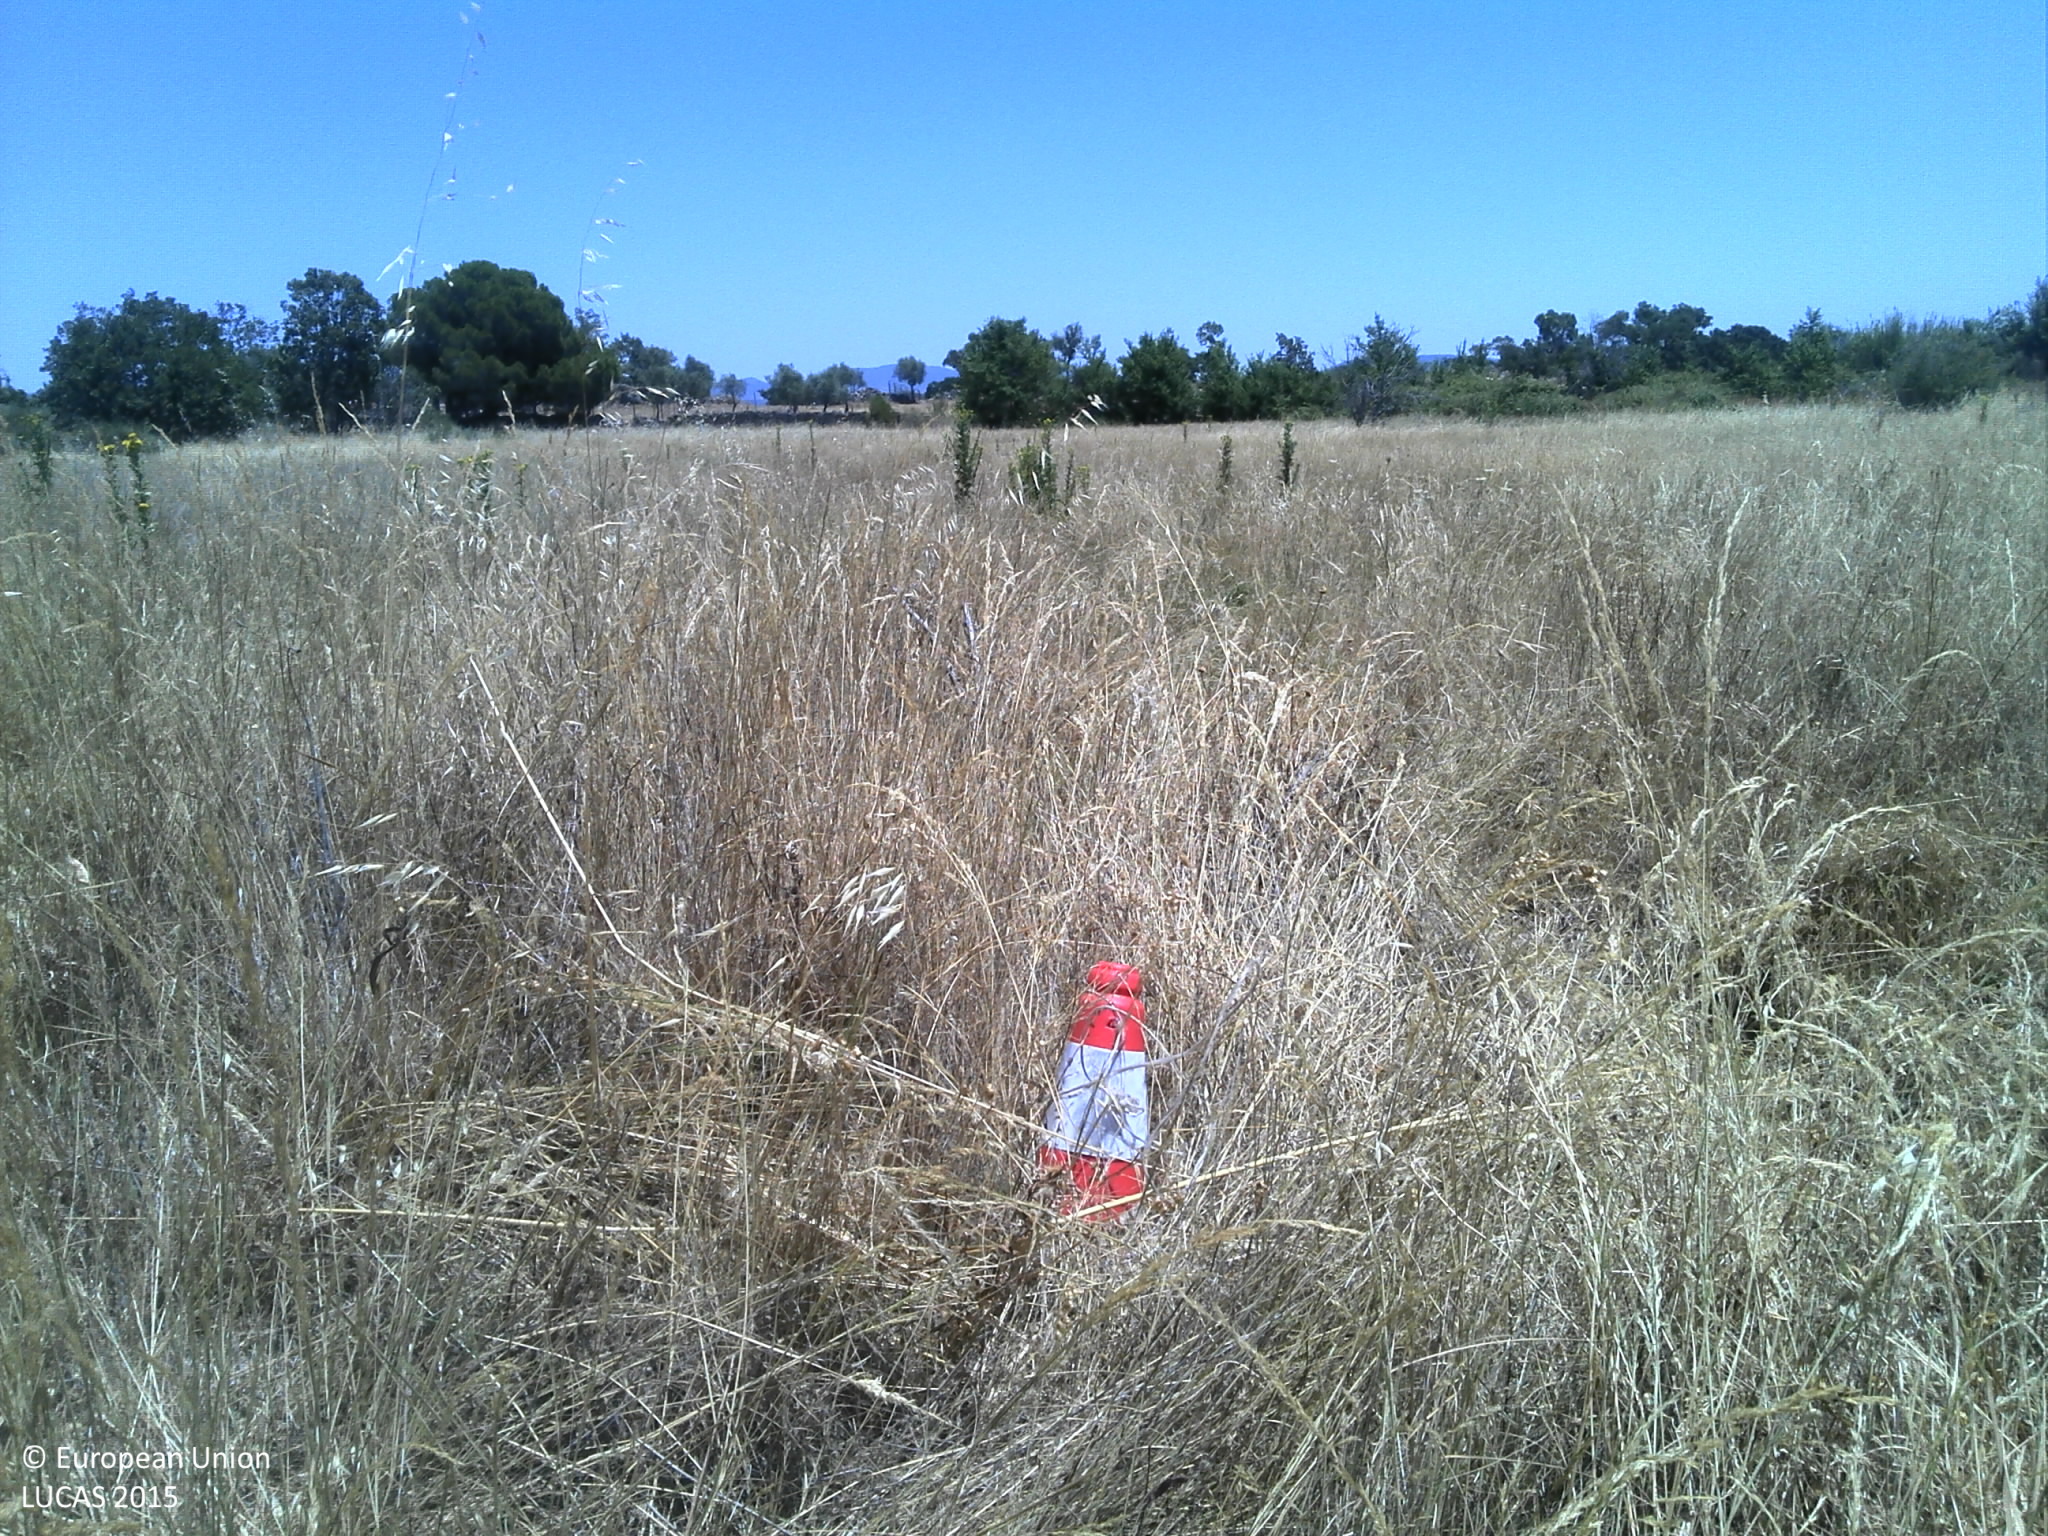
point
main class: Grassland
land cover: Grassland without tree/shrub cover
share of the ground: 50 - 75 %
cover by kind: herbaceous plants 75 %, unconsolidated bare surface 15 %
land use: Agriculture (excluding fallow land and kitchen gardens)
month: June
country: PT
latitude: 39.9455
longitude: -7.2415
